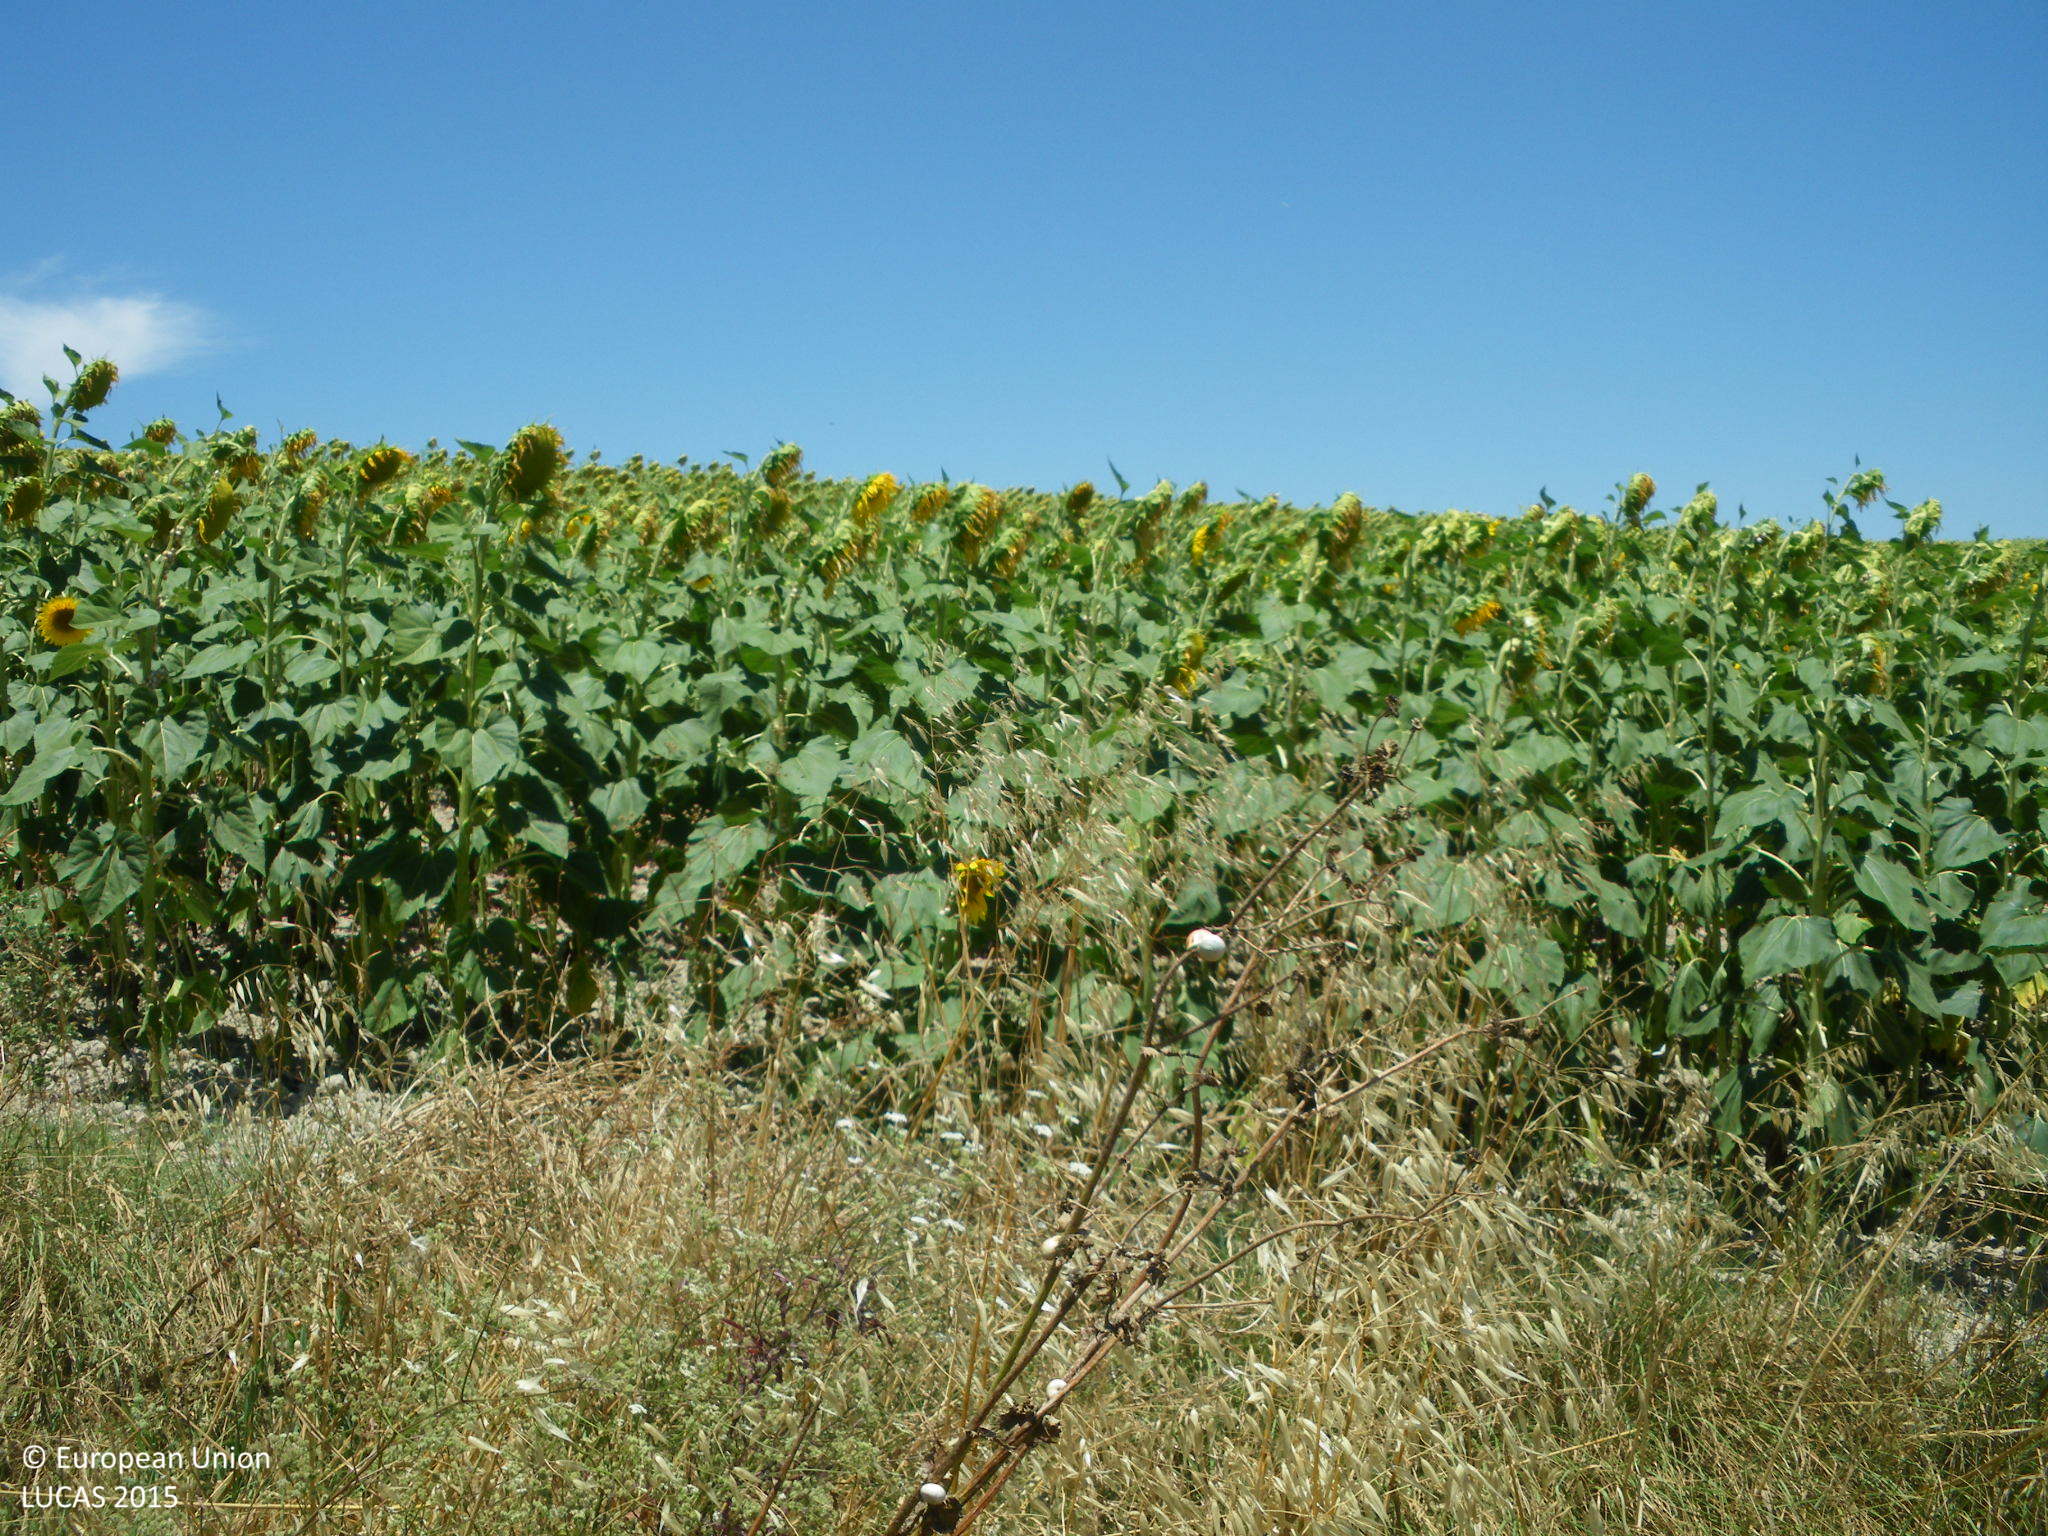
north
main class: Grassland
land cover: Grassland without tree/shrub cover
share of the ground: > 75 %
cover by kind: herbaceous plants 100 %
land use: Semi-natural and natural areas not in use
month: June
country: ES
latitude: 36.9080
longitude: -5.7345
